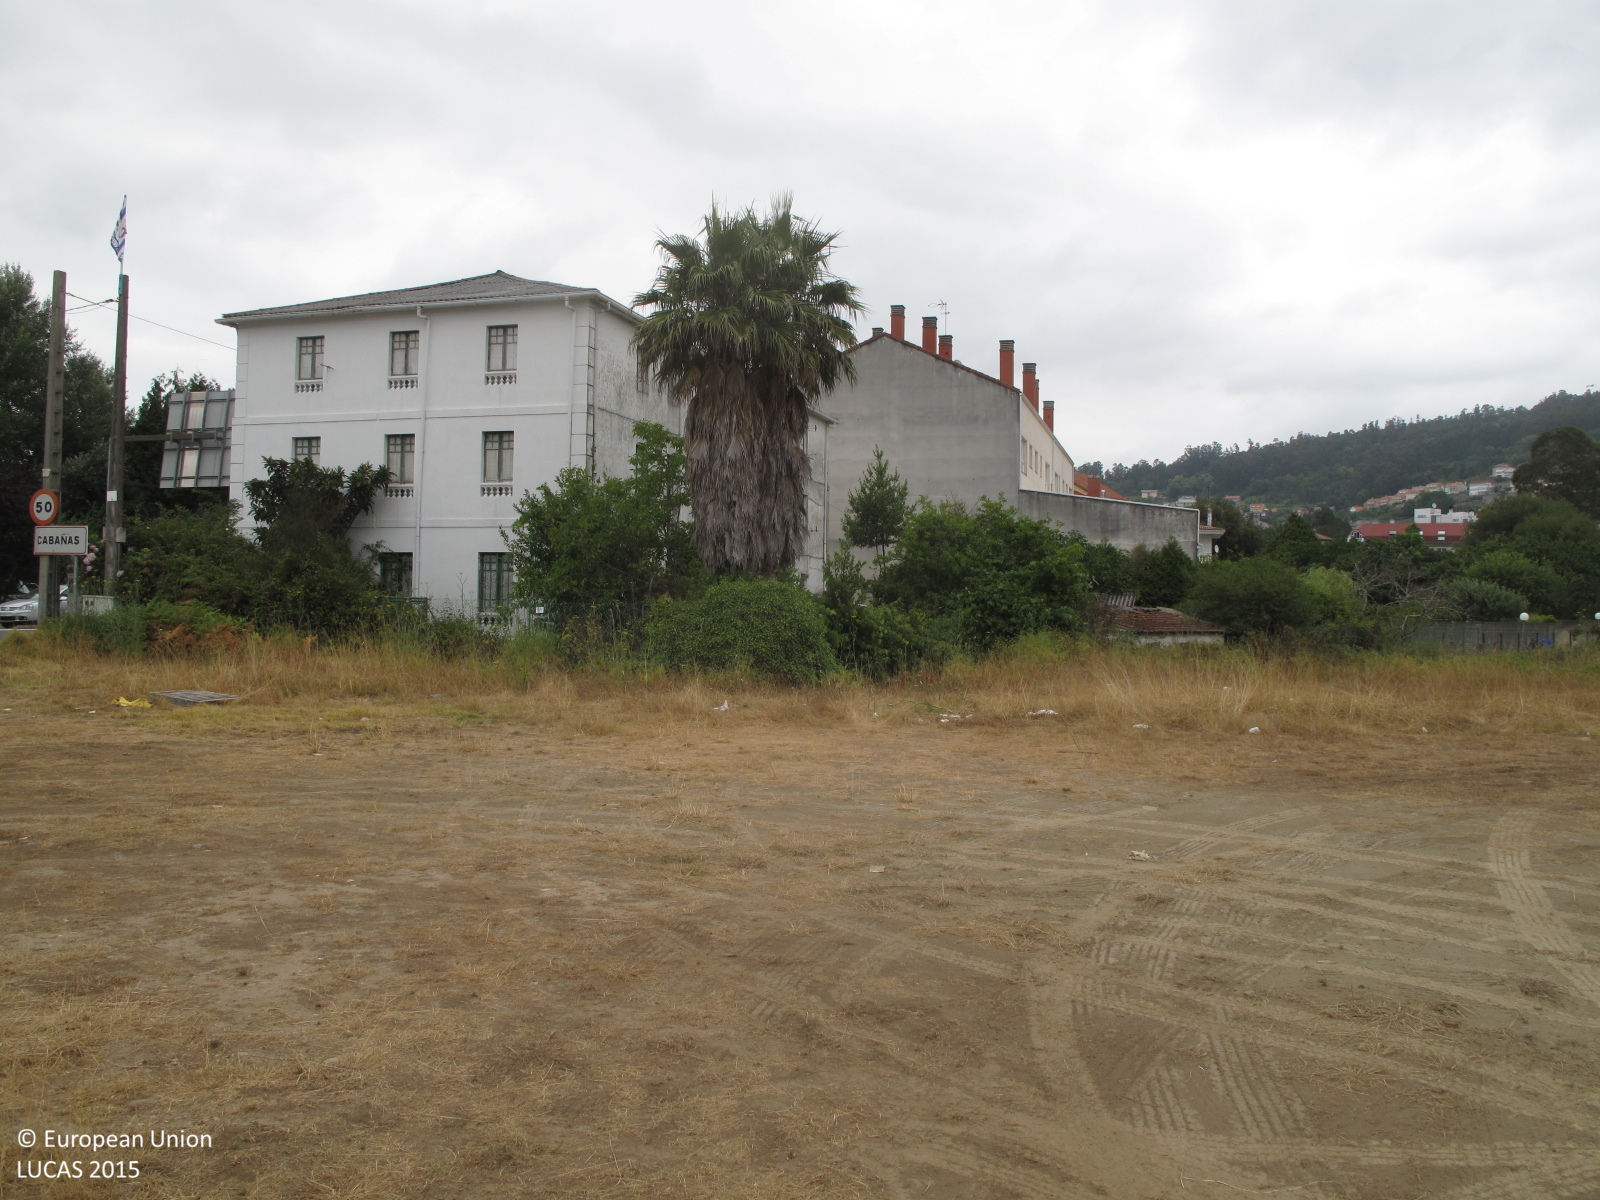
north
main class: Grassland
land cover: Spontaneously vegetated surfaces
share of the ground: 10 - 25 %
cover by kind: unconsolidated bare surface 80 %, herbaceous plants 20 %
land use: Abandoned areas
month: July
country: ES
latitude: 43.4129
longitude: -8.1678
